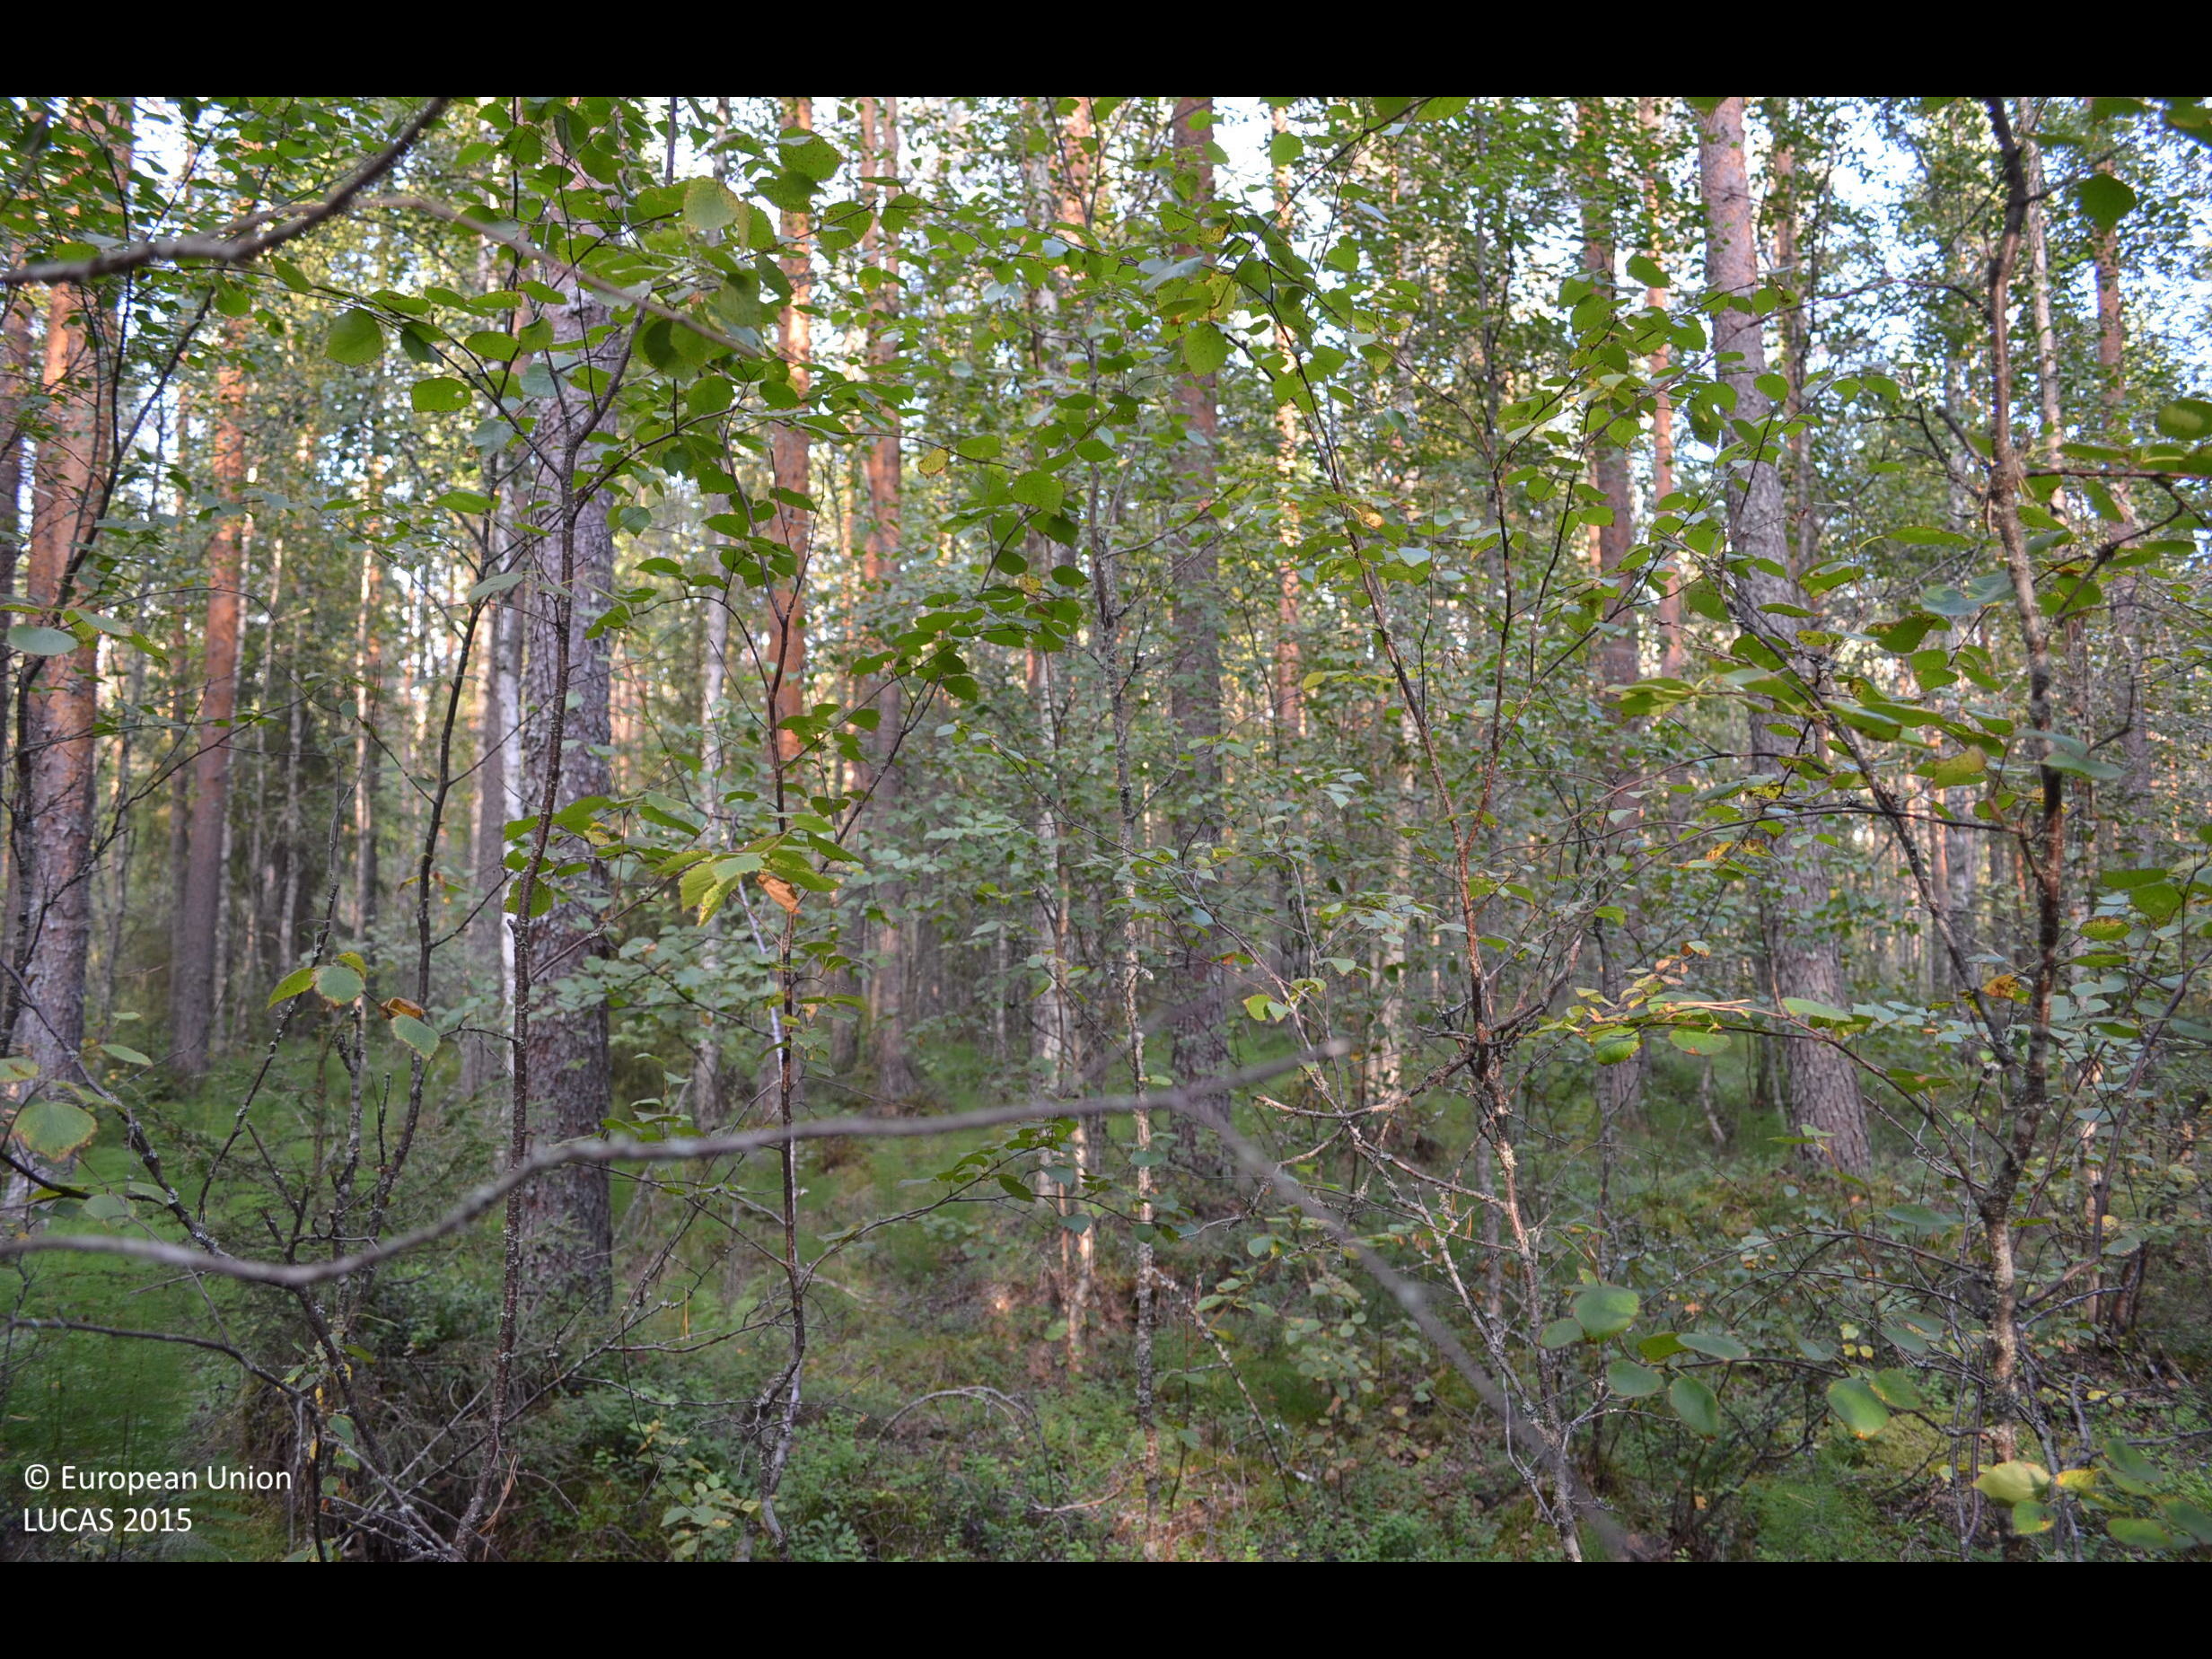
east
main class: Woodland
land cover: Pine dominated mixed woodland
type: boreal forest
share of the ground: > 75 %
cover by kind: coniferous forest trees 60 %, broadleaved forest trees 25 %, shrubs 10 %, herbaceous plants 5 %
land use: Forestry
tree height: > 5 m
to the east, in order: Pine dominated mixed woodland; Ditches and canals; Pine dominated mixed woodland; Ditches and canals; Pine dominated coniferous woodland; Ditches and canals; Pine dominated mixed woodland
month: August
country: FI
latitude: 62.4086
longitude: 24.4300
